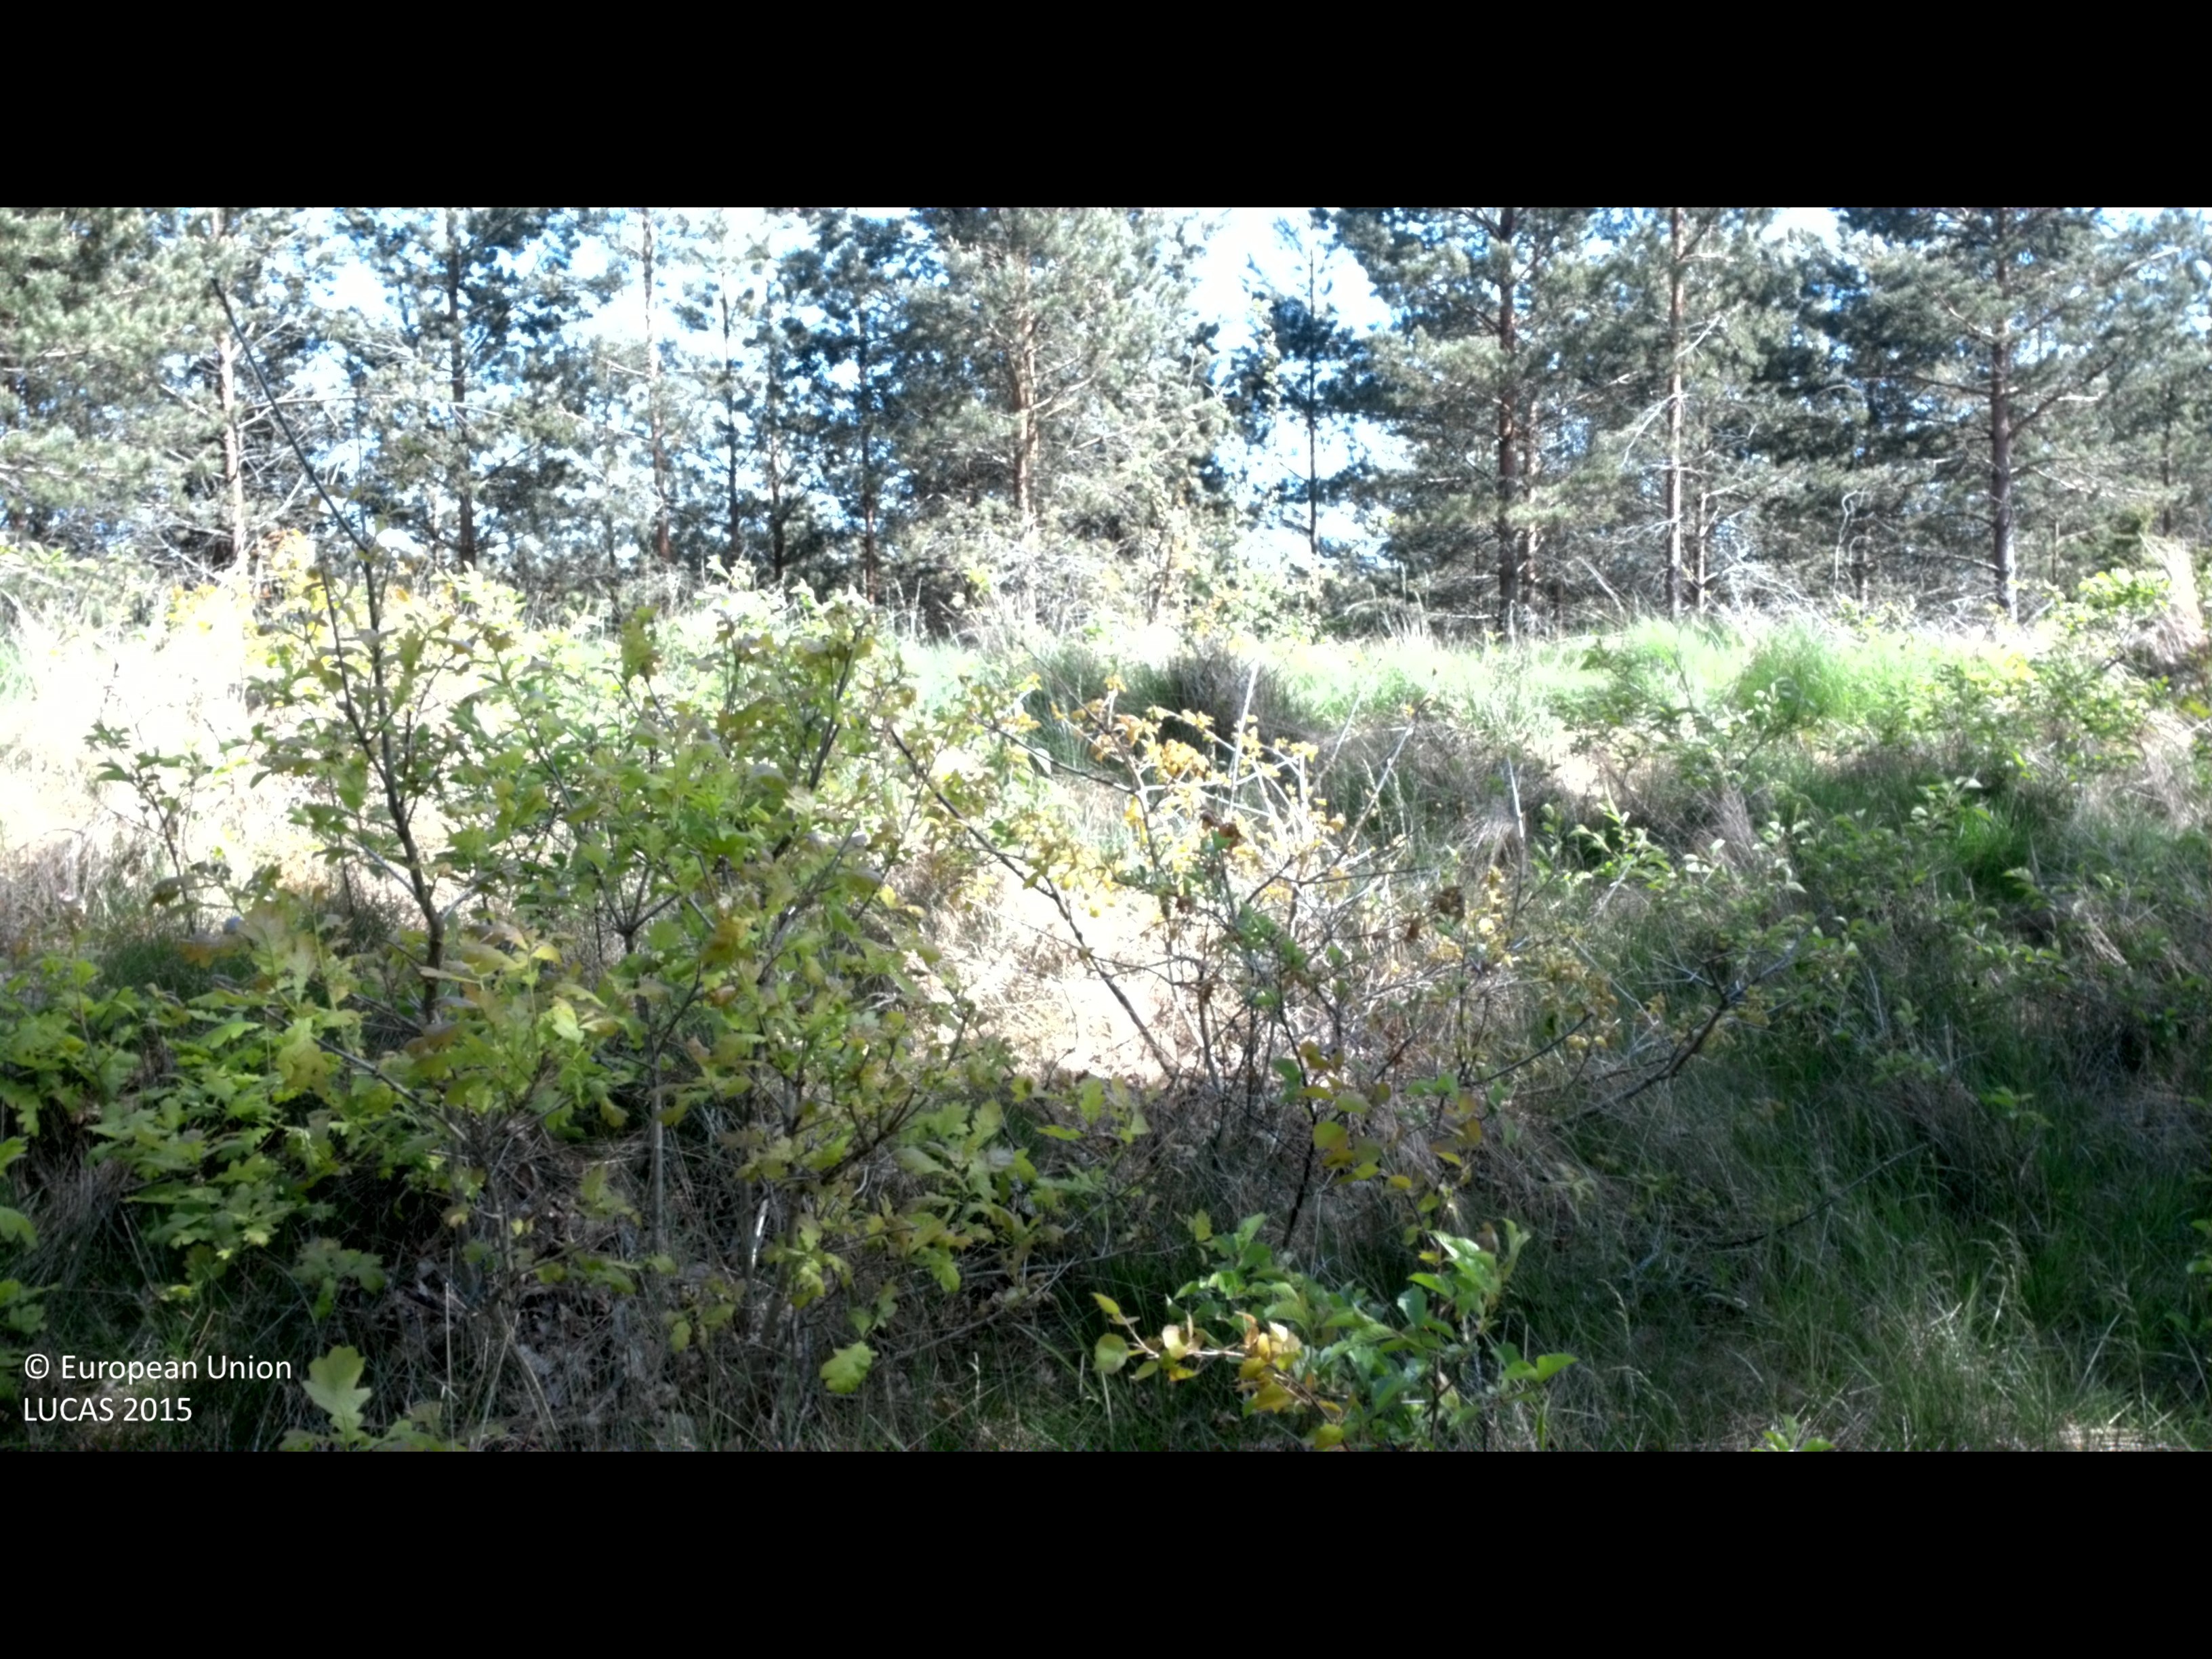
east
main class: Woodland
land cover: Pine dominated coniferous woodland
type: boreal forest
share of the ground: 25 - 50 %
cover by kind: coniferous forest trees 60 %, shrubs 15 %, herbaceous plants 15 %, broadleaved forest trees 10 %
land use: Forestry
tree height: > 5 m
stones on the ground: < 10 %
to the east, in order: Pine dominated coniferous woodland; Shrubland with sparse tree cover; Pine dominated coniferous woodland; Shrubland with sparse tree cover; Paved roads, cycling and walking lanes; Other bare soil; Pine dominated coniferous woodland
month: May
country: SE
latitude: 57.2964
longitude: 16.2886
